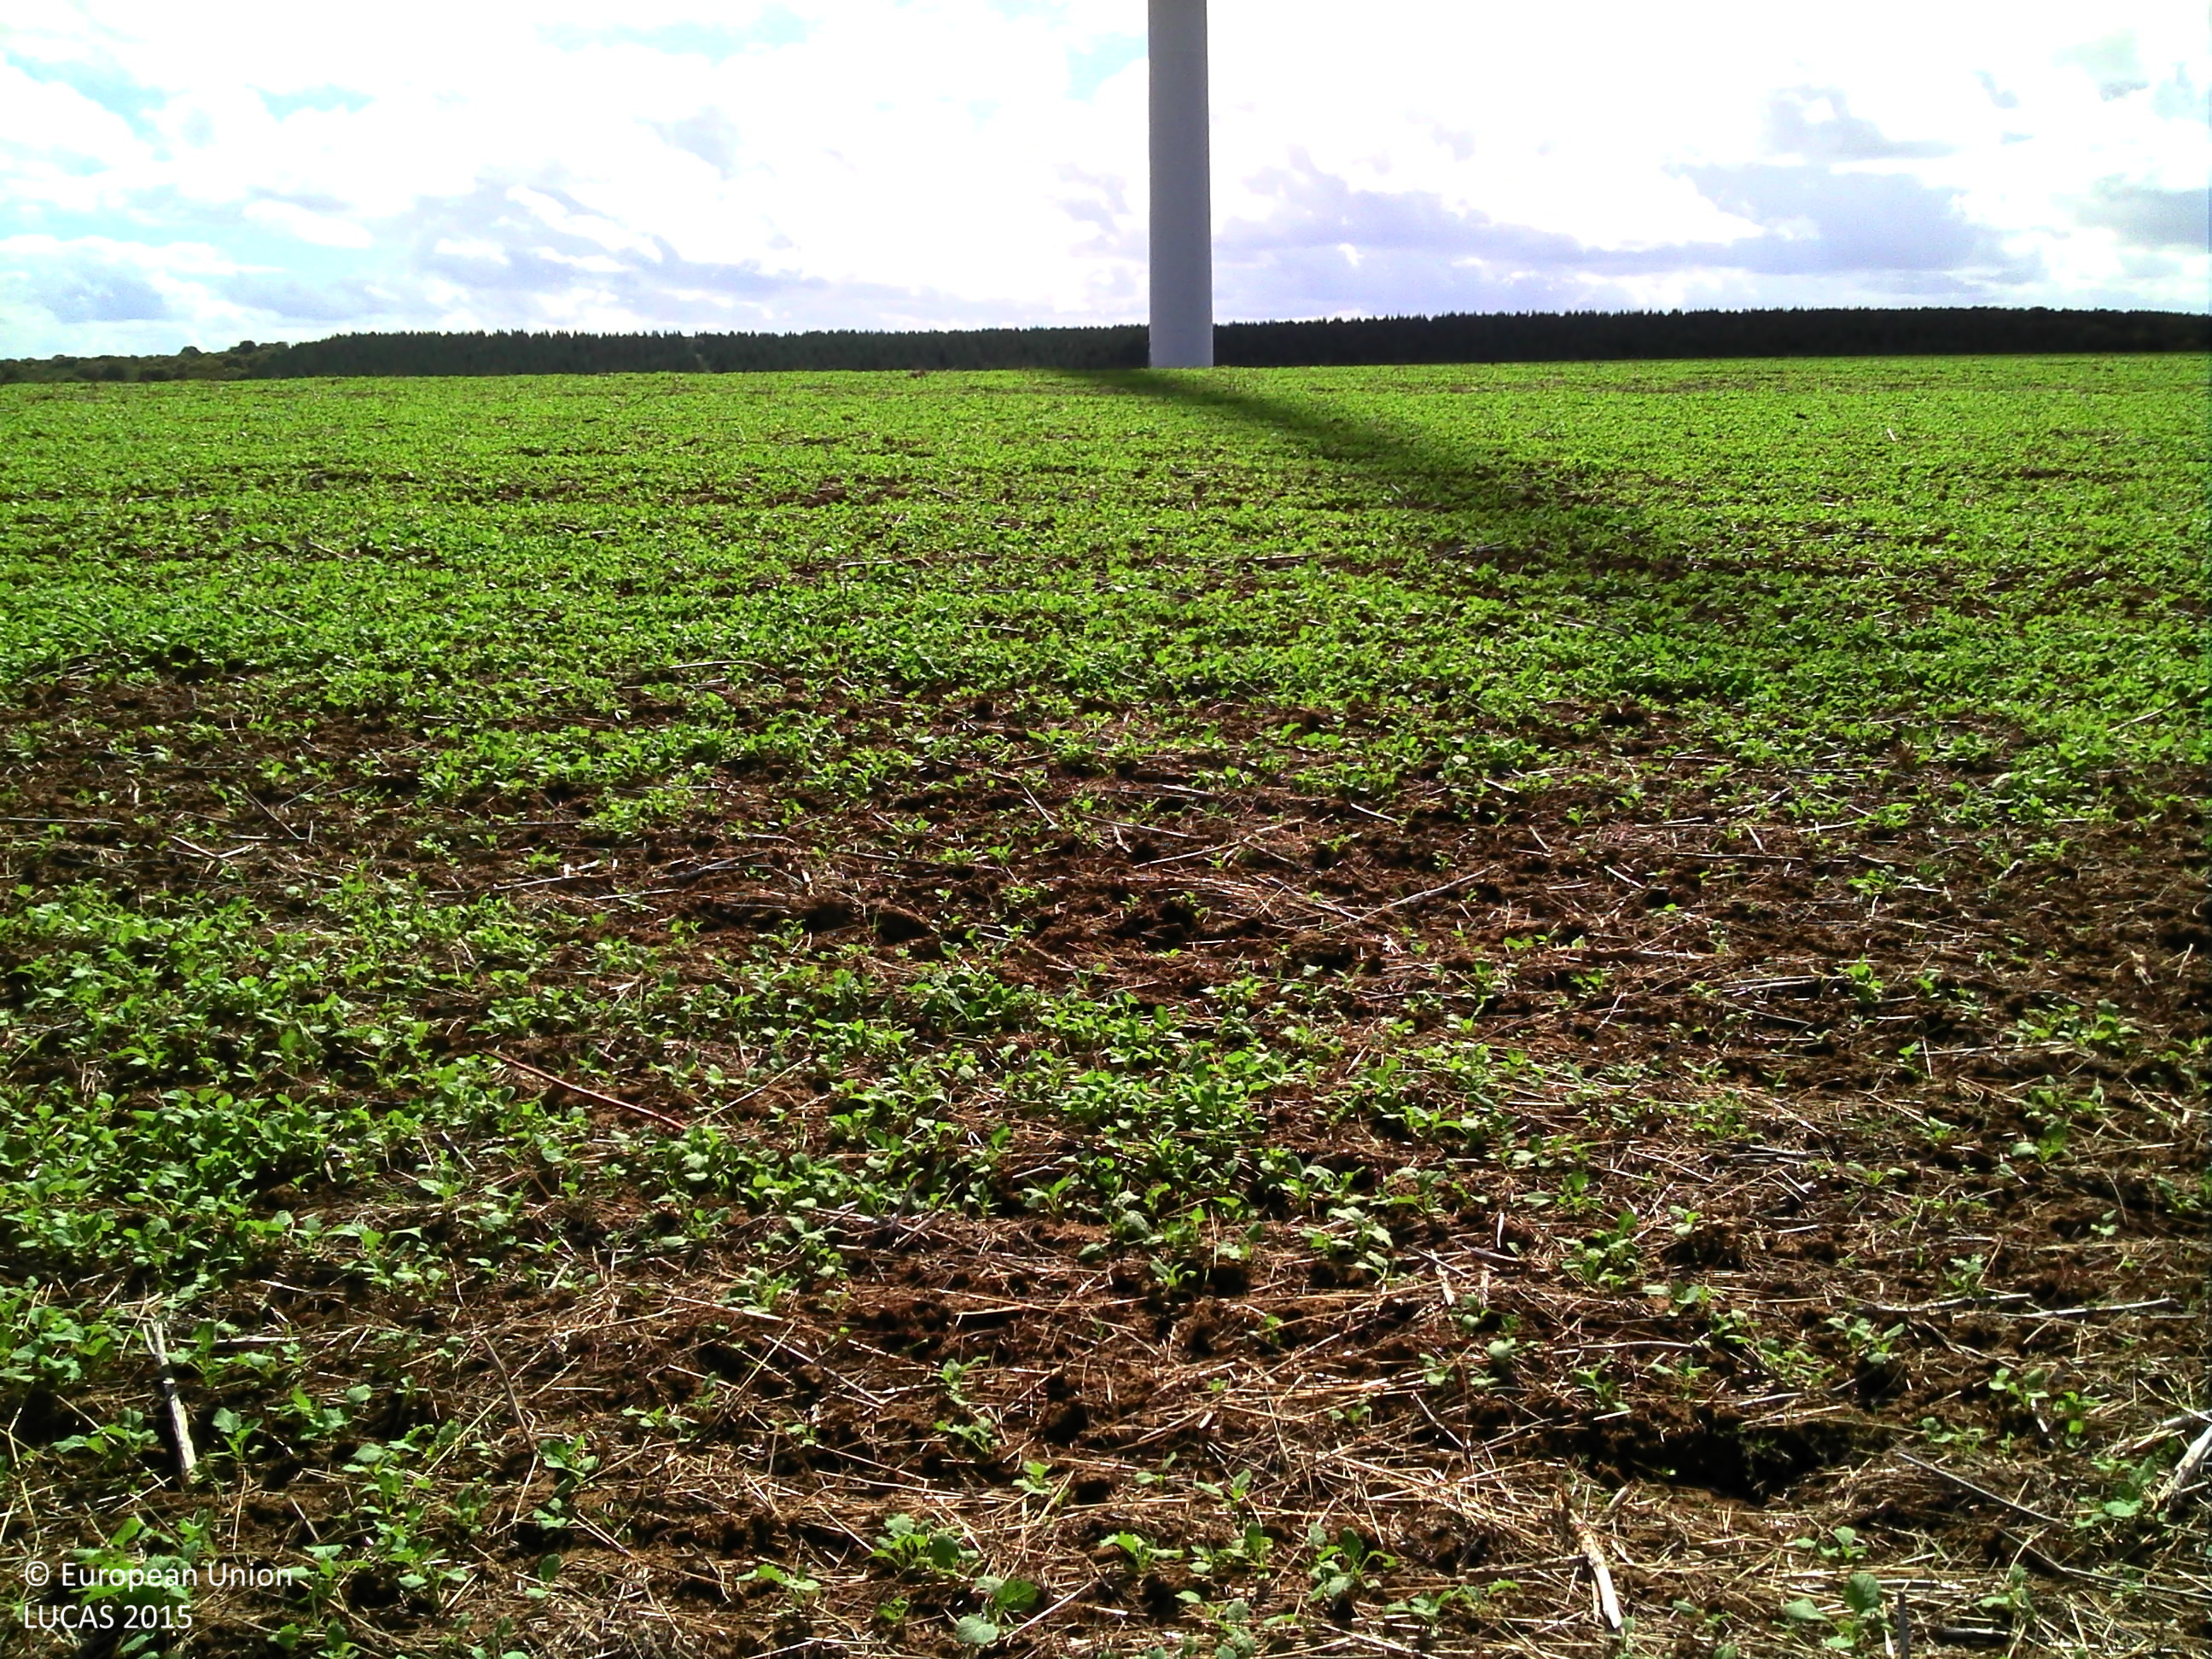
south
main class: Cropland
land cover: Rape and turnip rape
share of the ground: 10 - 25 %
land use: Agriculture (excluding fallow land and kitchen gardens)
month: September
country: FR
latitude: 48.2945
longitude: 4.7007
